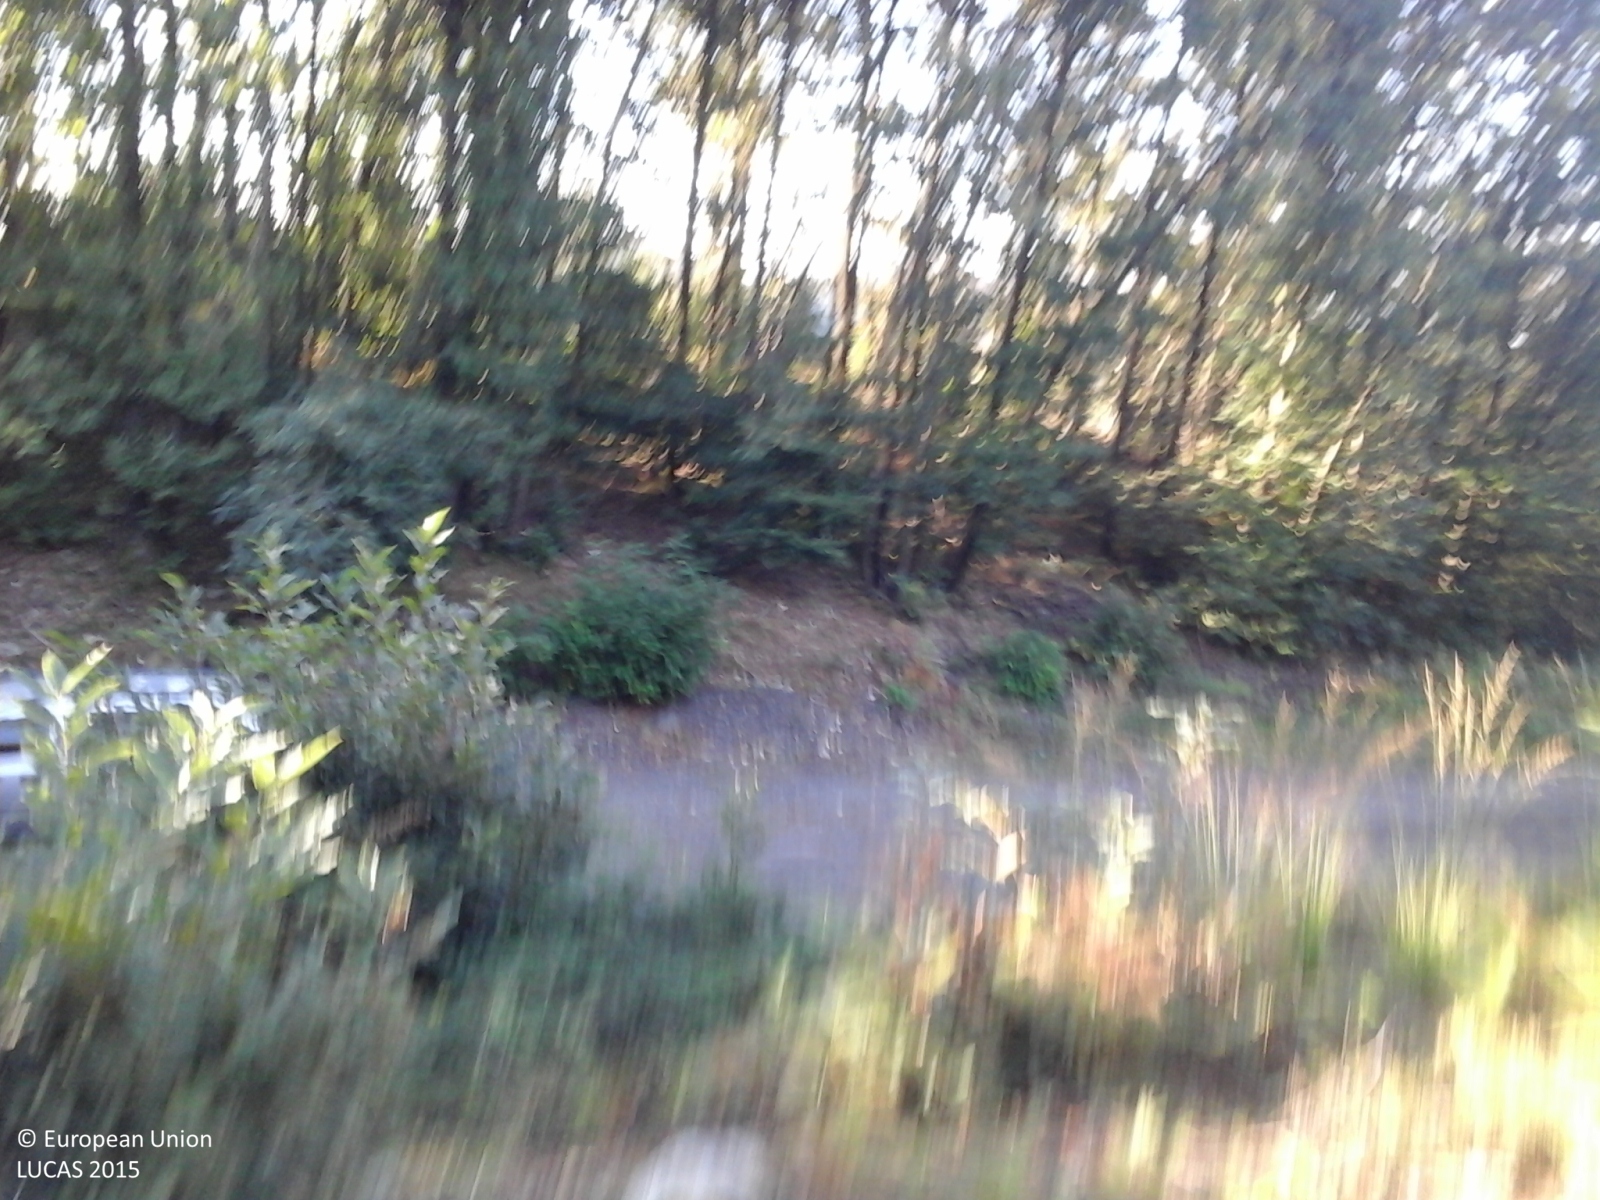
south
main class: Woodland
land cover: Broadleaved woodland
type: thermophilous deciduous forest
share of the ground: > 75 %
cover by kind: broadleaved forest trees 60 %, herbaceous plants 40 %
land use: Forestry
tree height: > 5 m
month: September
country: IT
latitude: 44.5055
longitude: 8.7575
